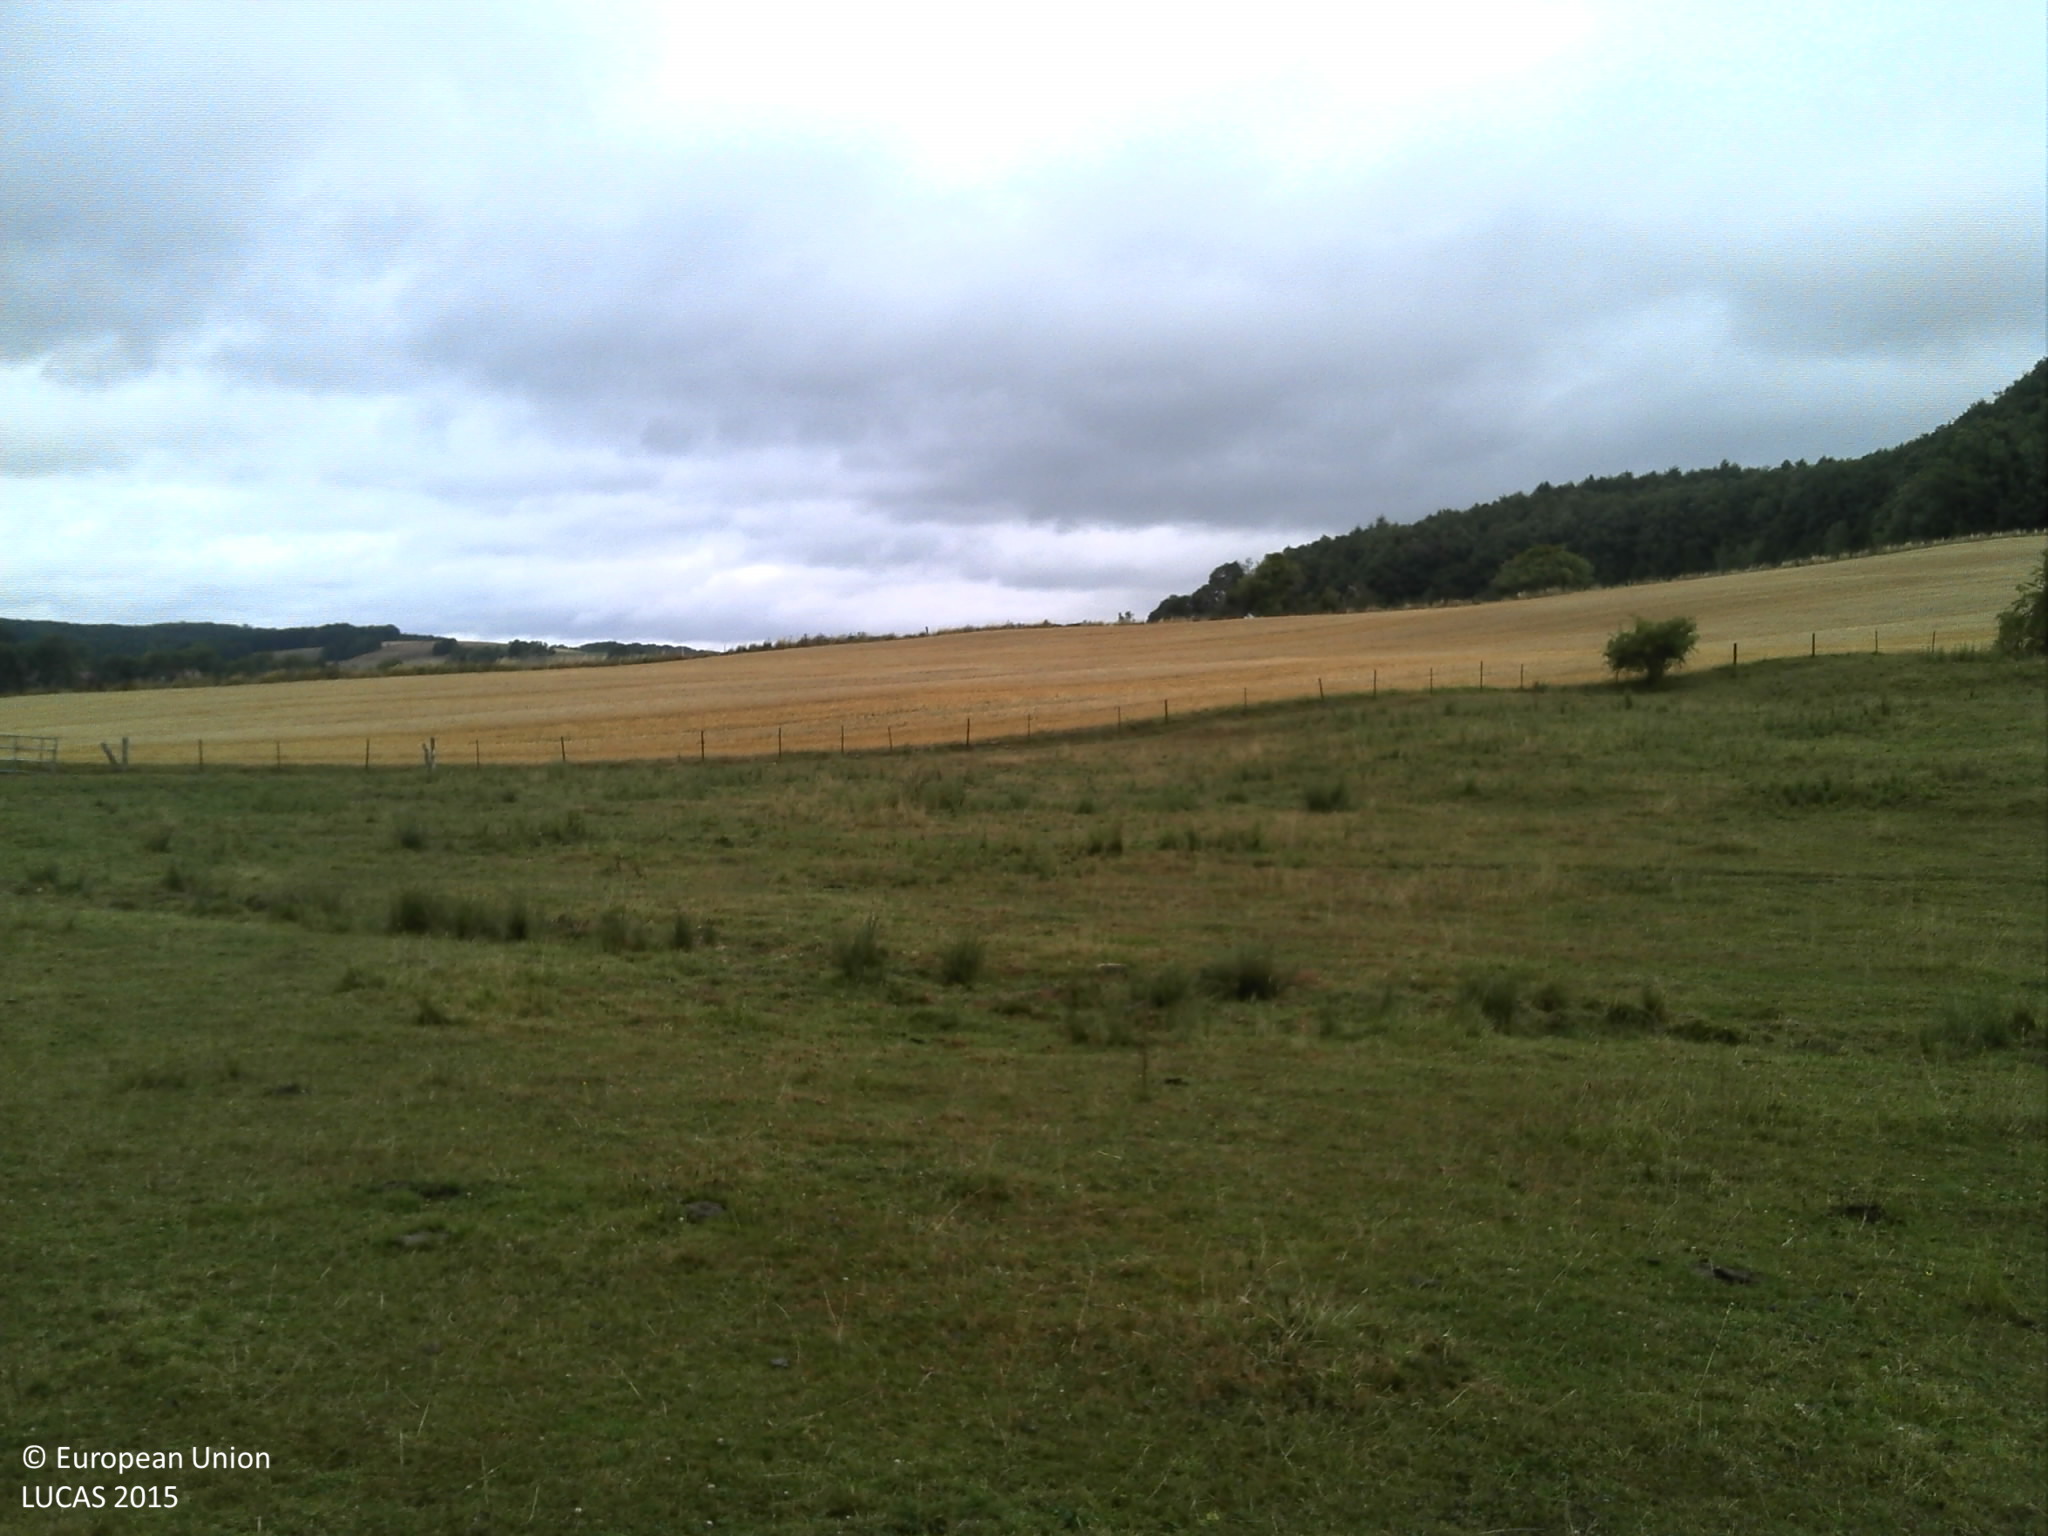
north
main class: Grassland
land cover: Grassland without tree/shrub cover
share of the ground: > 75 %
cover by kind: herbaceous plants 100 %
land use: Agriculture (excluding fallow land and kitchen gardens)
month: July
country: FR
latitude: 49.4335
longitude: 4.7709
